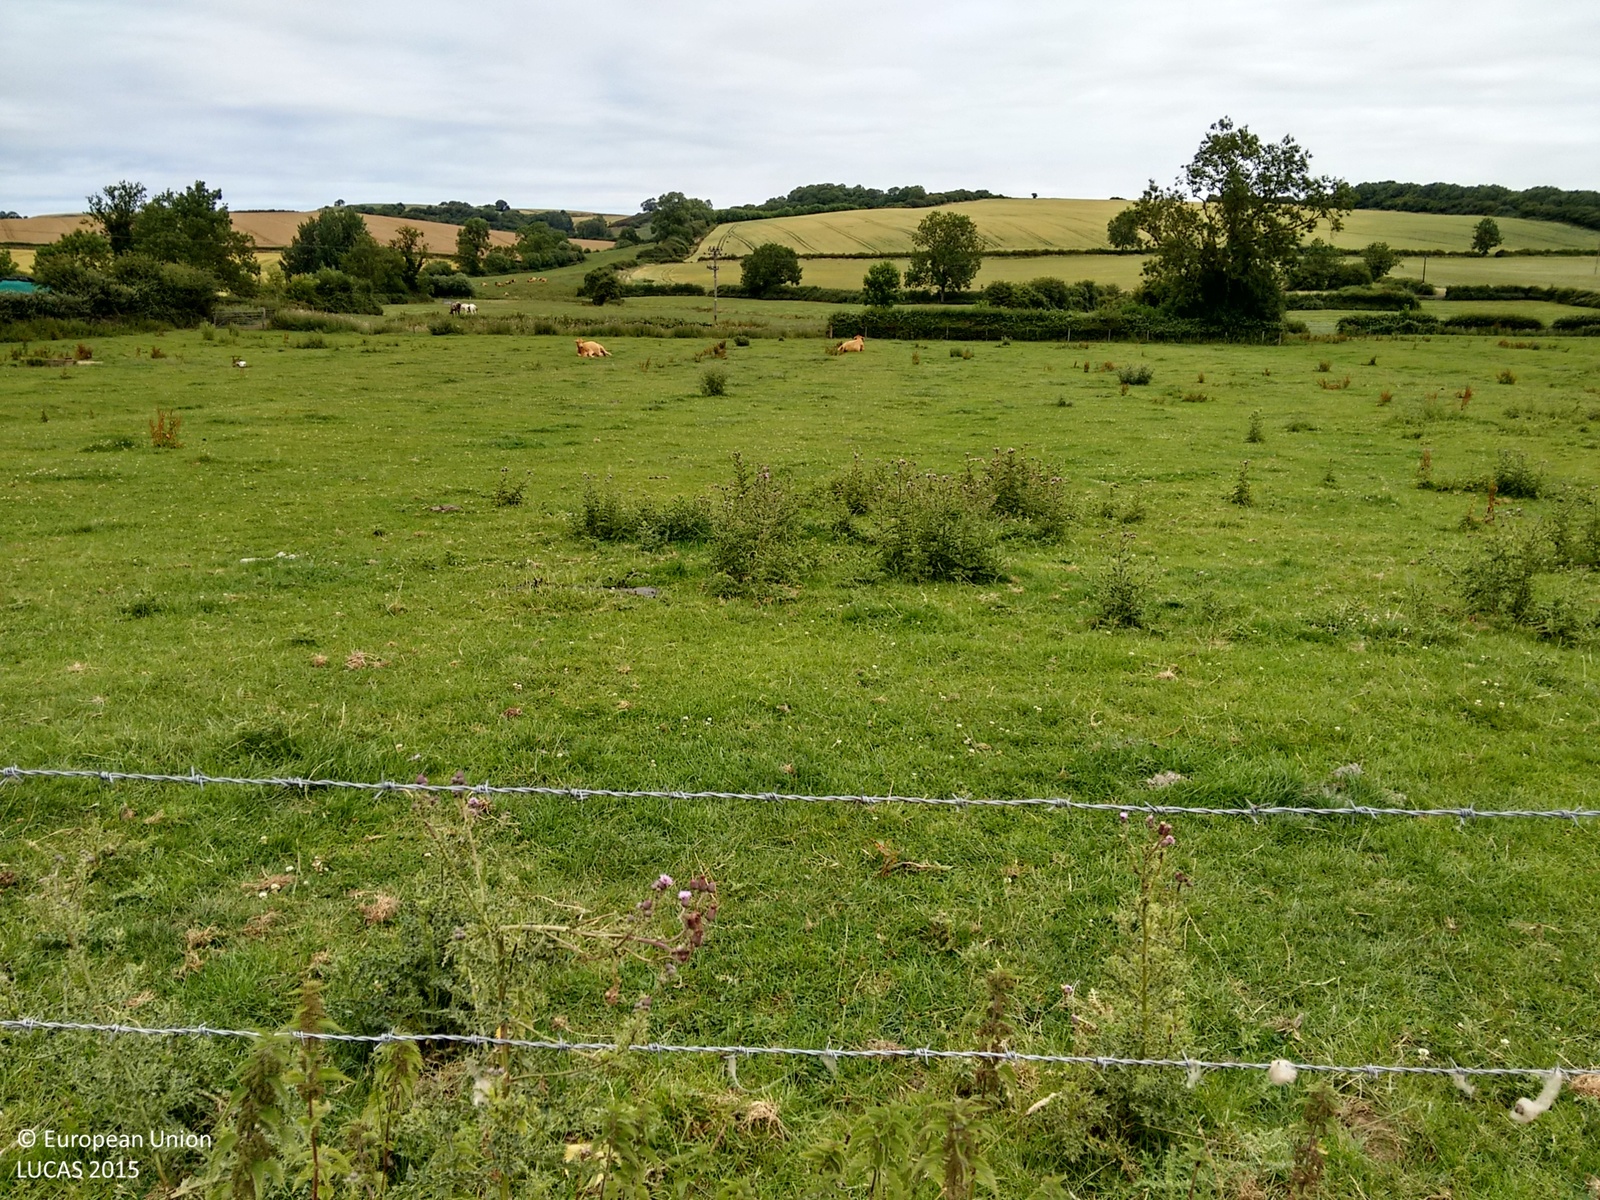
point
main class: Grassland
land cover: Grassland without tree/shrub cover
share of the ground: > 75 %
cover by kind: herbaceous plants 100 %
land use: Agriculture (excluding fallow land and kitchen gardens)
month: July
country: GB
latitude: 52.5266
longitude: -0.9062
